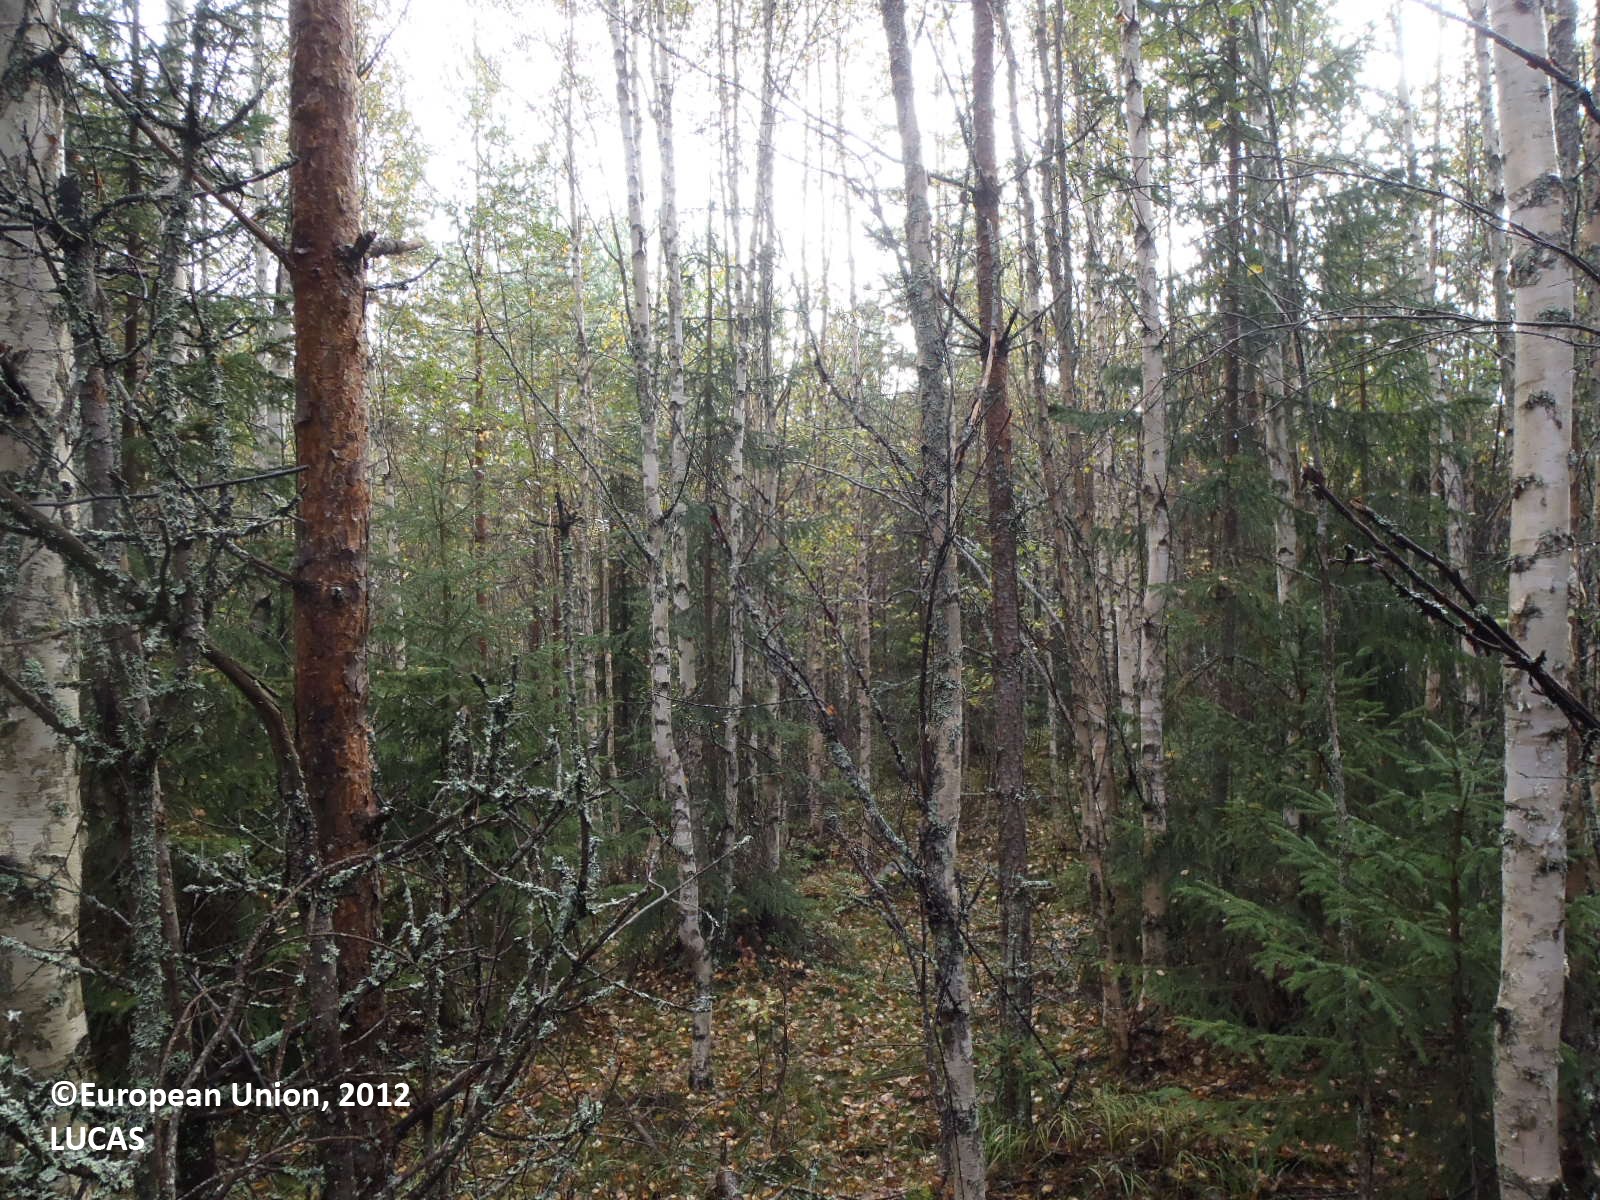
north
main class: Woodland
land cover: Pine dominated mixed woodland
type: boreal forest
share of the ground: > 75 %
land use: Forestry
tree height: > 5 m
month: September
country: FI
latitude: 61.6771
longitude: 22.8205
